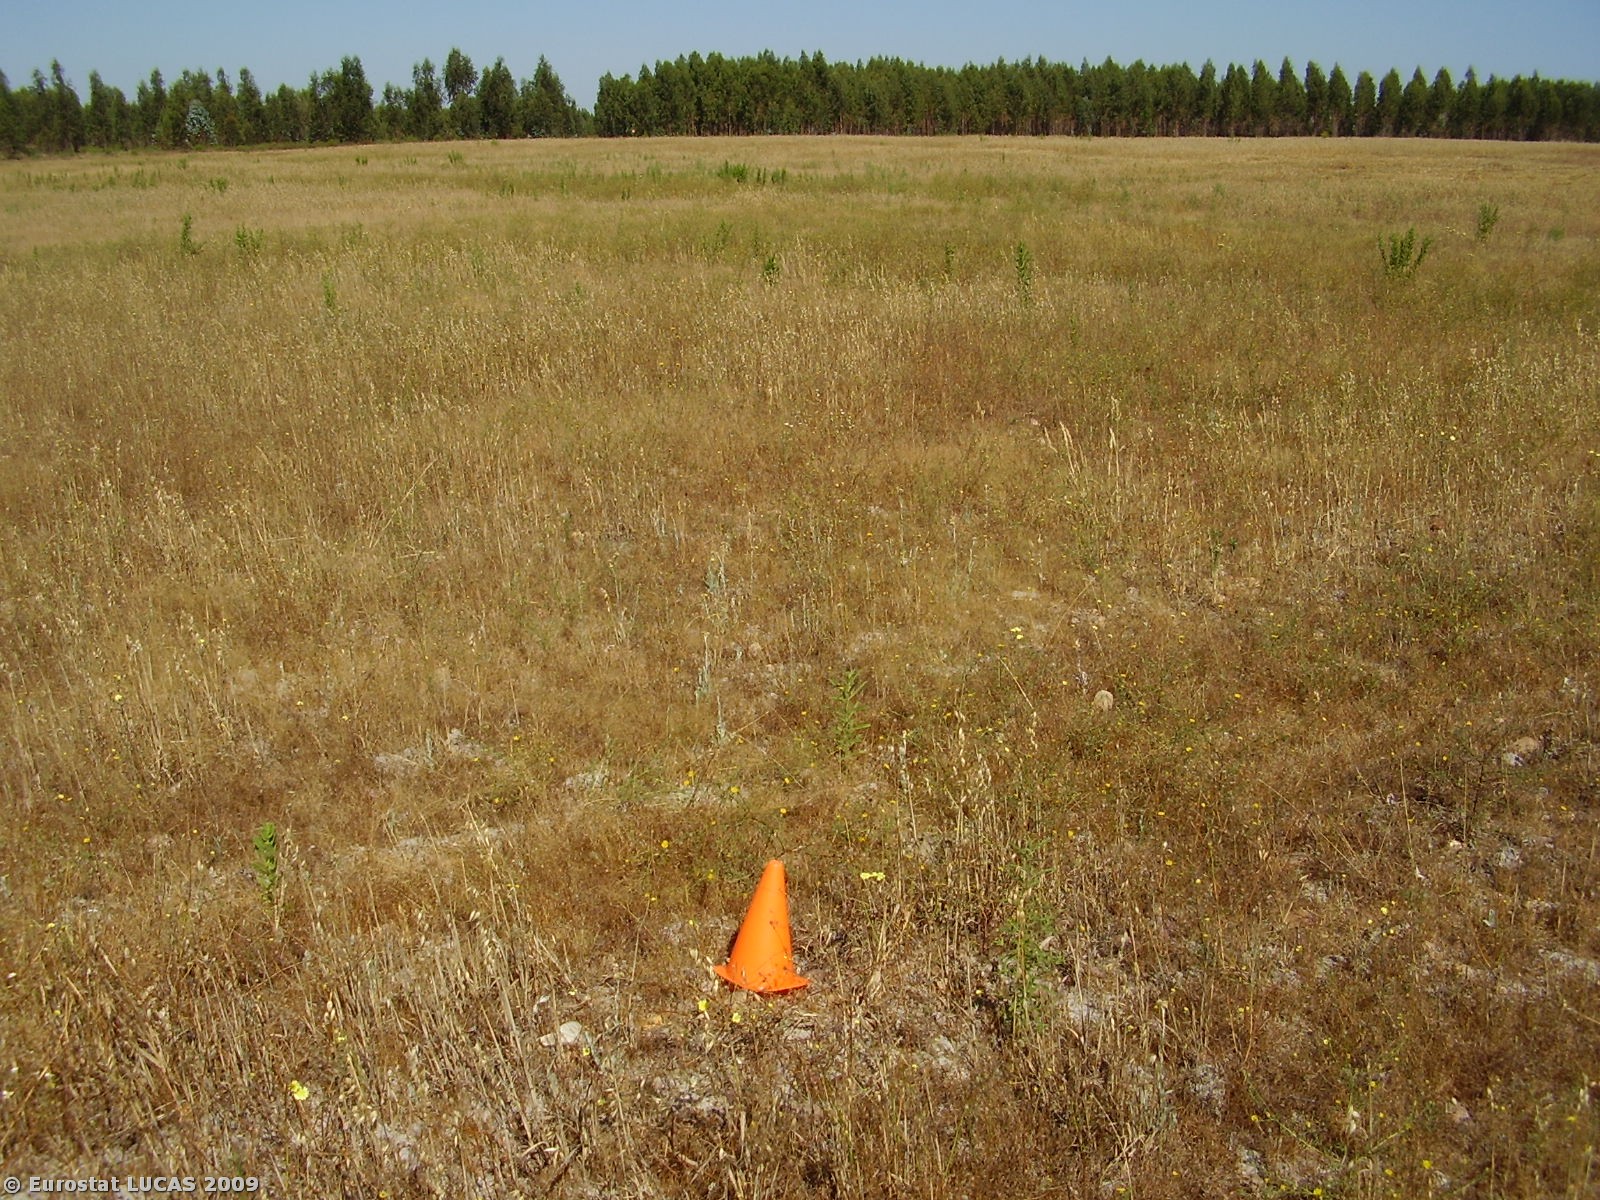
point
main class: Cropland
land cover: Oats
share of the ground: 50 - 75 %
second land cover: Spontaneously vegetated surfaces
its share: 10 - 25 %
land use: Agriculture (excluding fallow land and kitchen gardens)
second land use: Fallow land
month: July
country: PT
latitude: 39.3754
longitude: -8.3252
